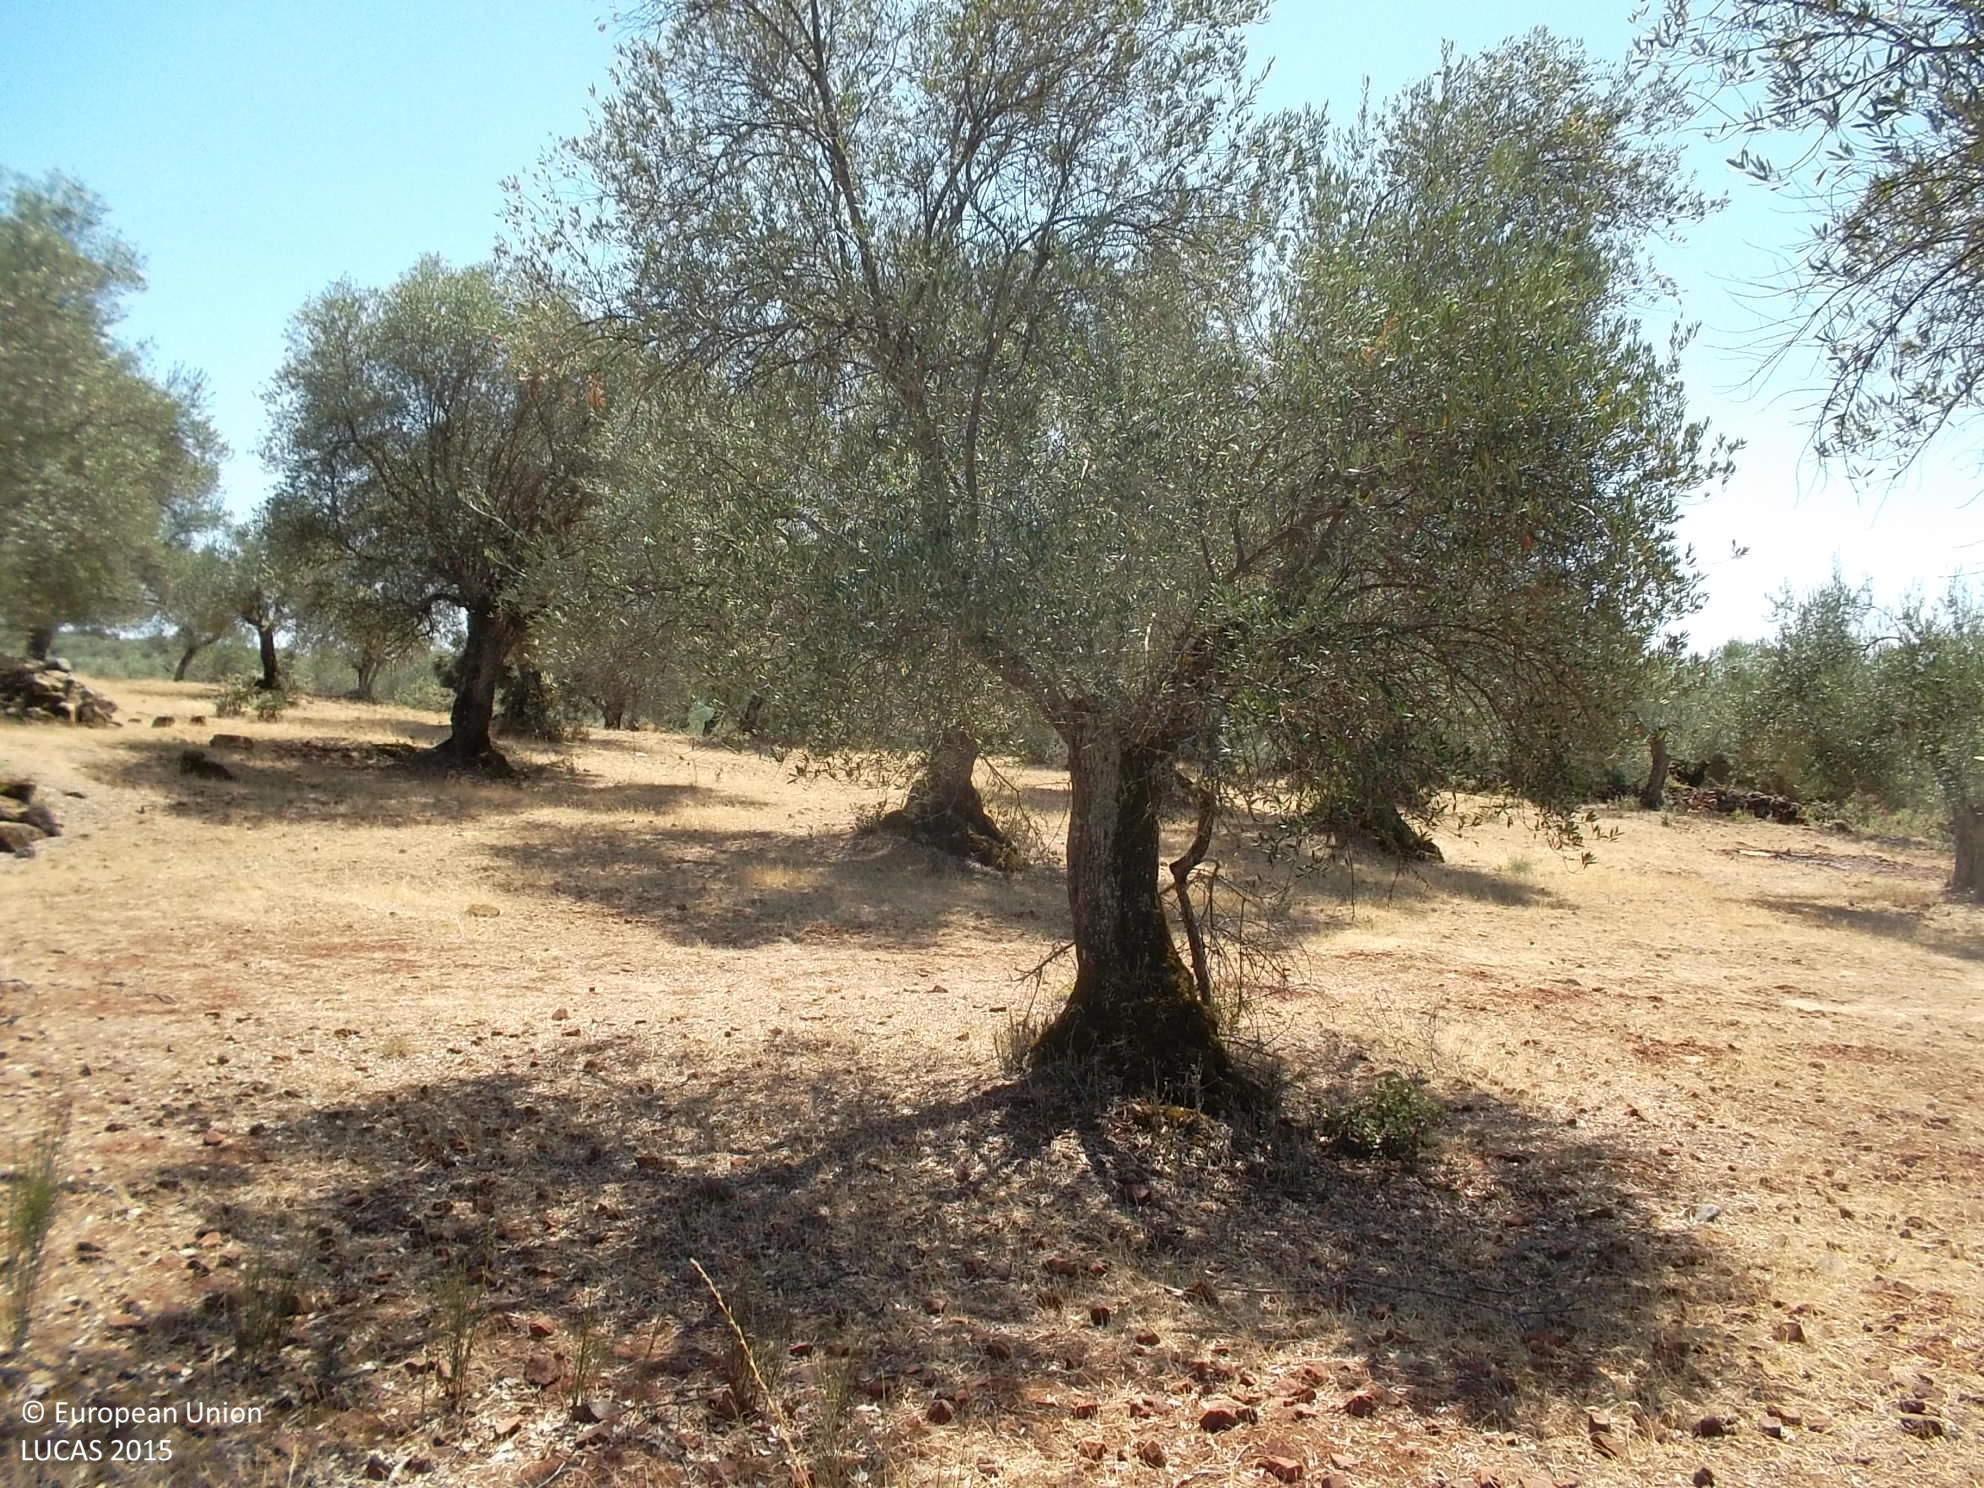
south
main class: Cropland
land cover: Olive groves
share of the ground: 10 - 25 %
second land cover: Other bare soil
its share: > 75 %
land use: Agriculture (excluding fallow land and kitchen gardens)
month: August
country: ES
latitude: 38.1603
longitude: -6.7025
